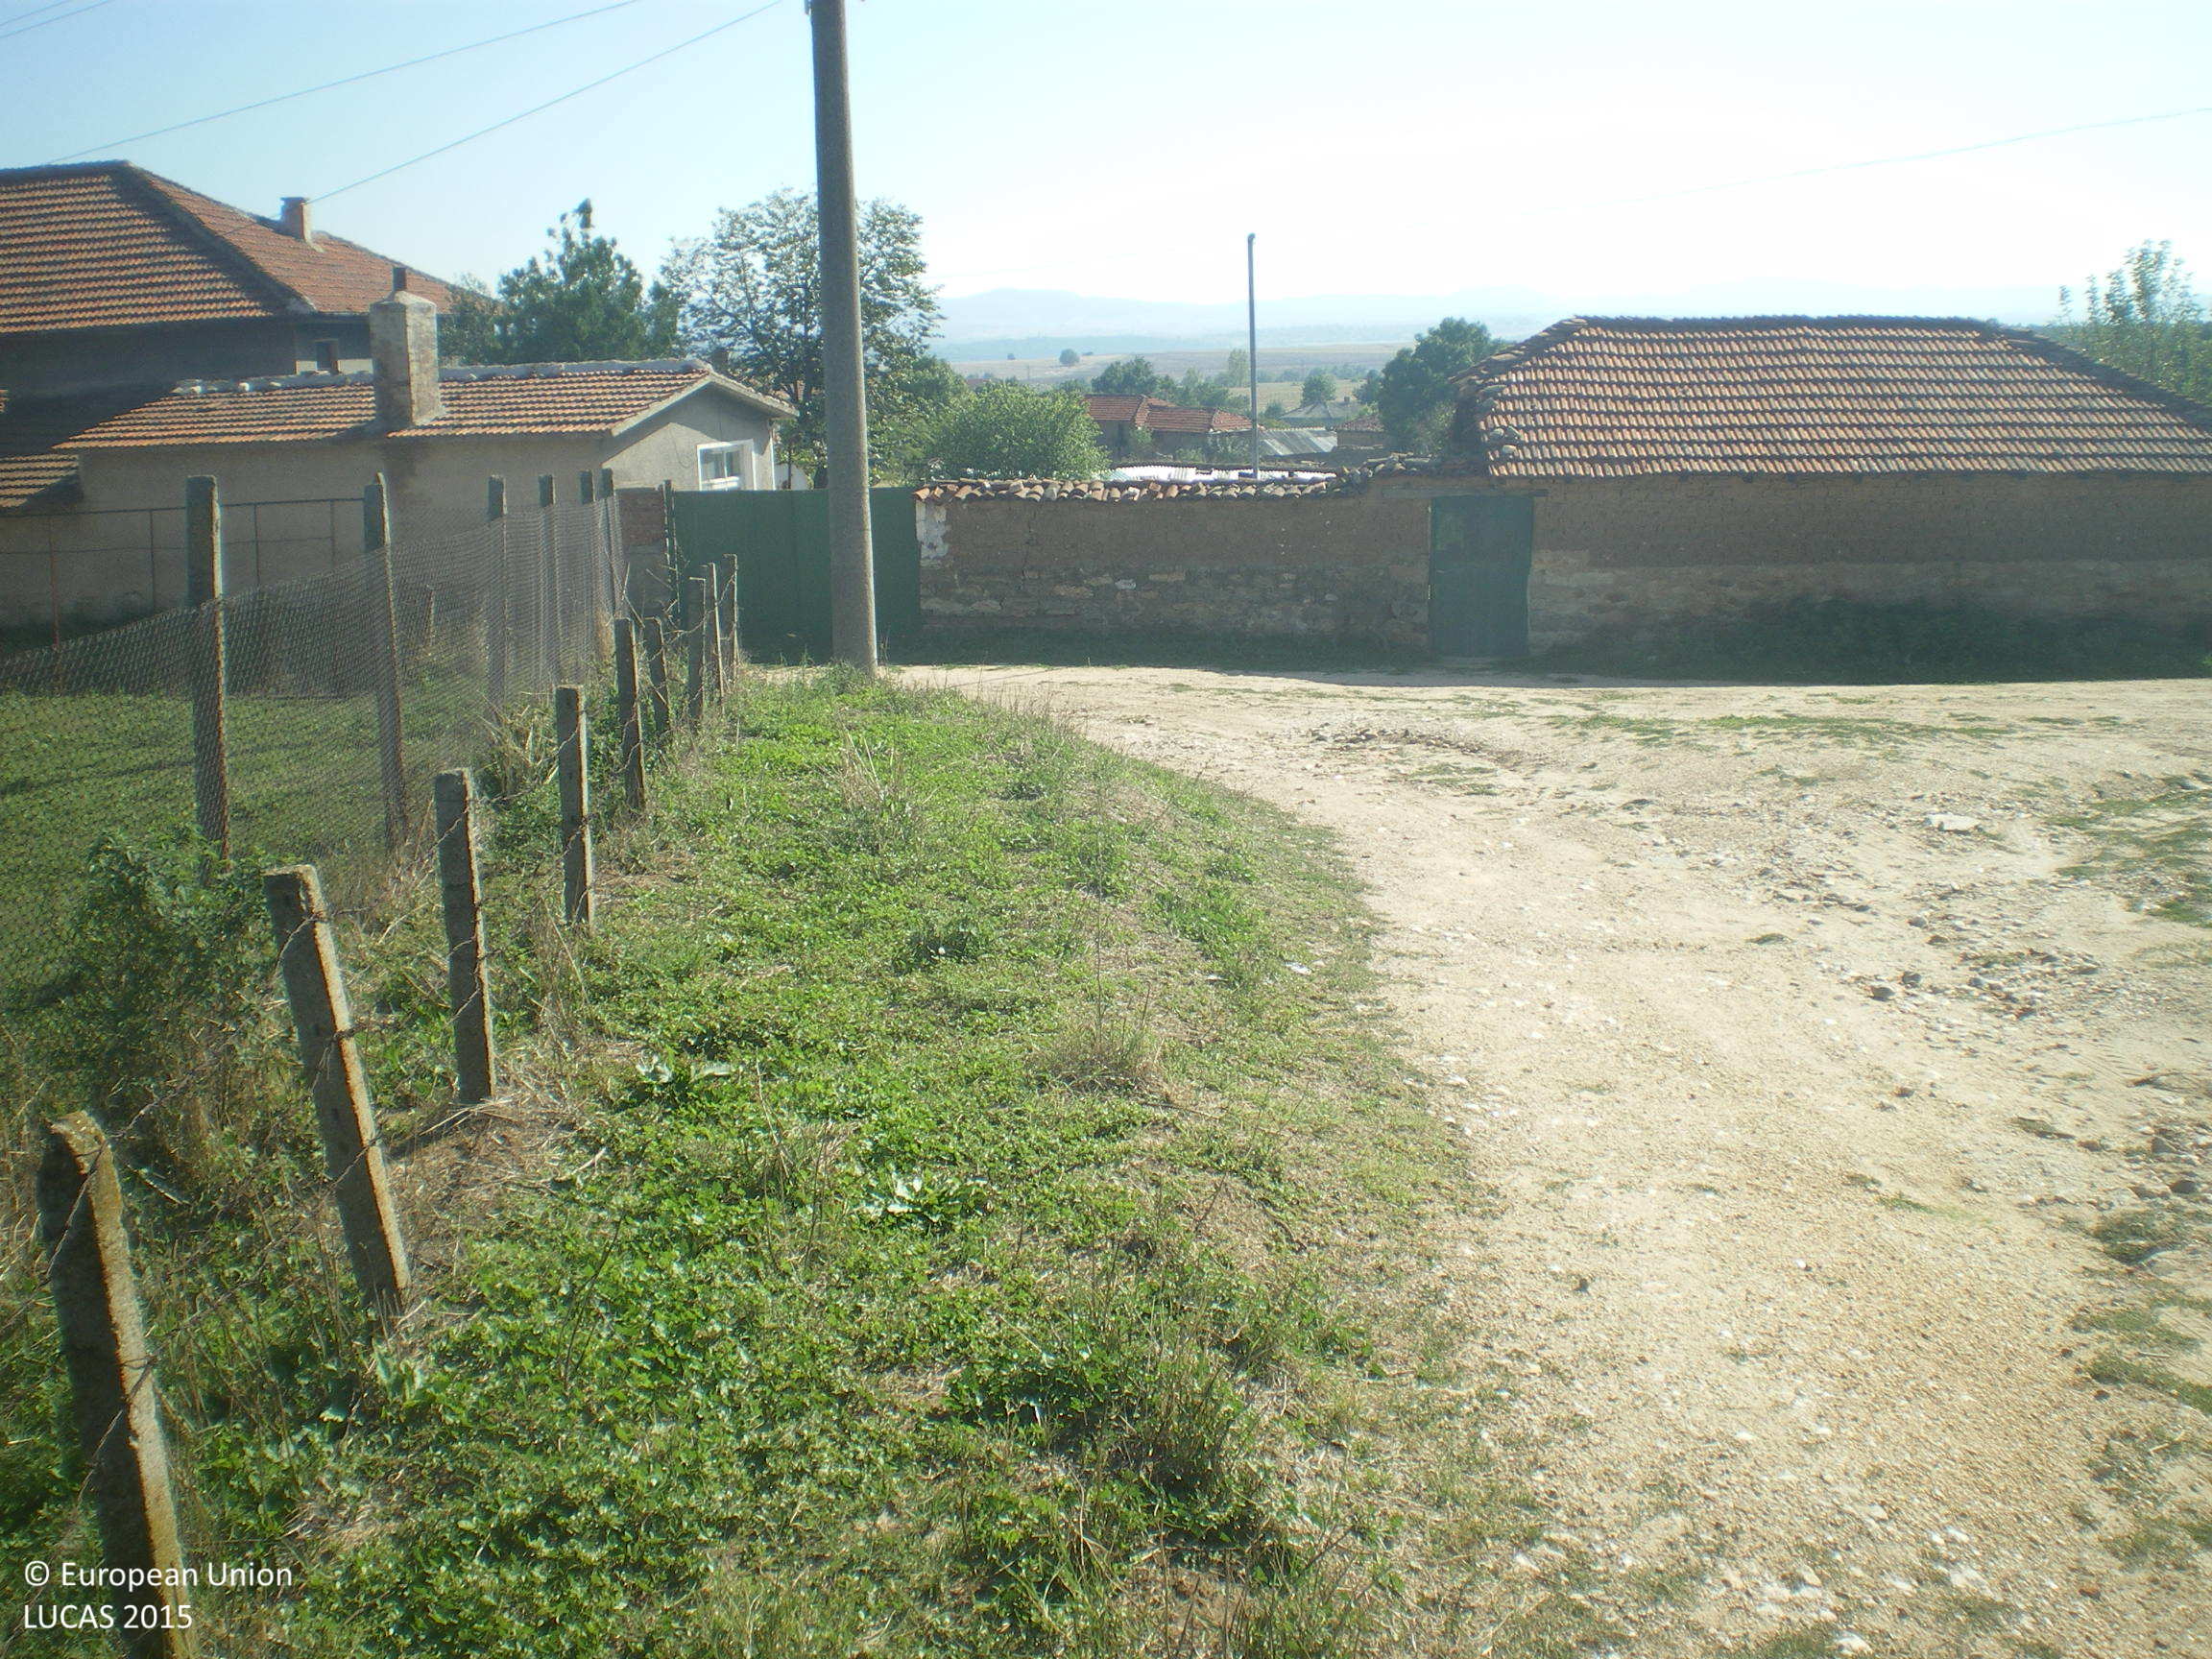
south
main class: Grassland
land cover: Grassland without tree/shrub cover
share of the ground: > 75 %
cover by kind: herbaceous plants 100 %
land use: Residential
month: September
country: BG
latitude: 41.8479
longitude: 25.7855
